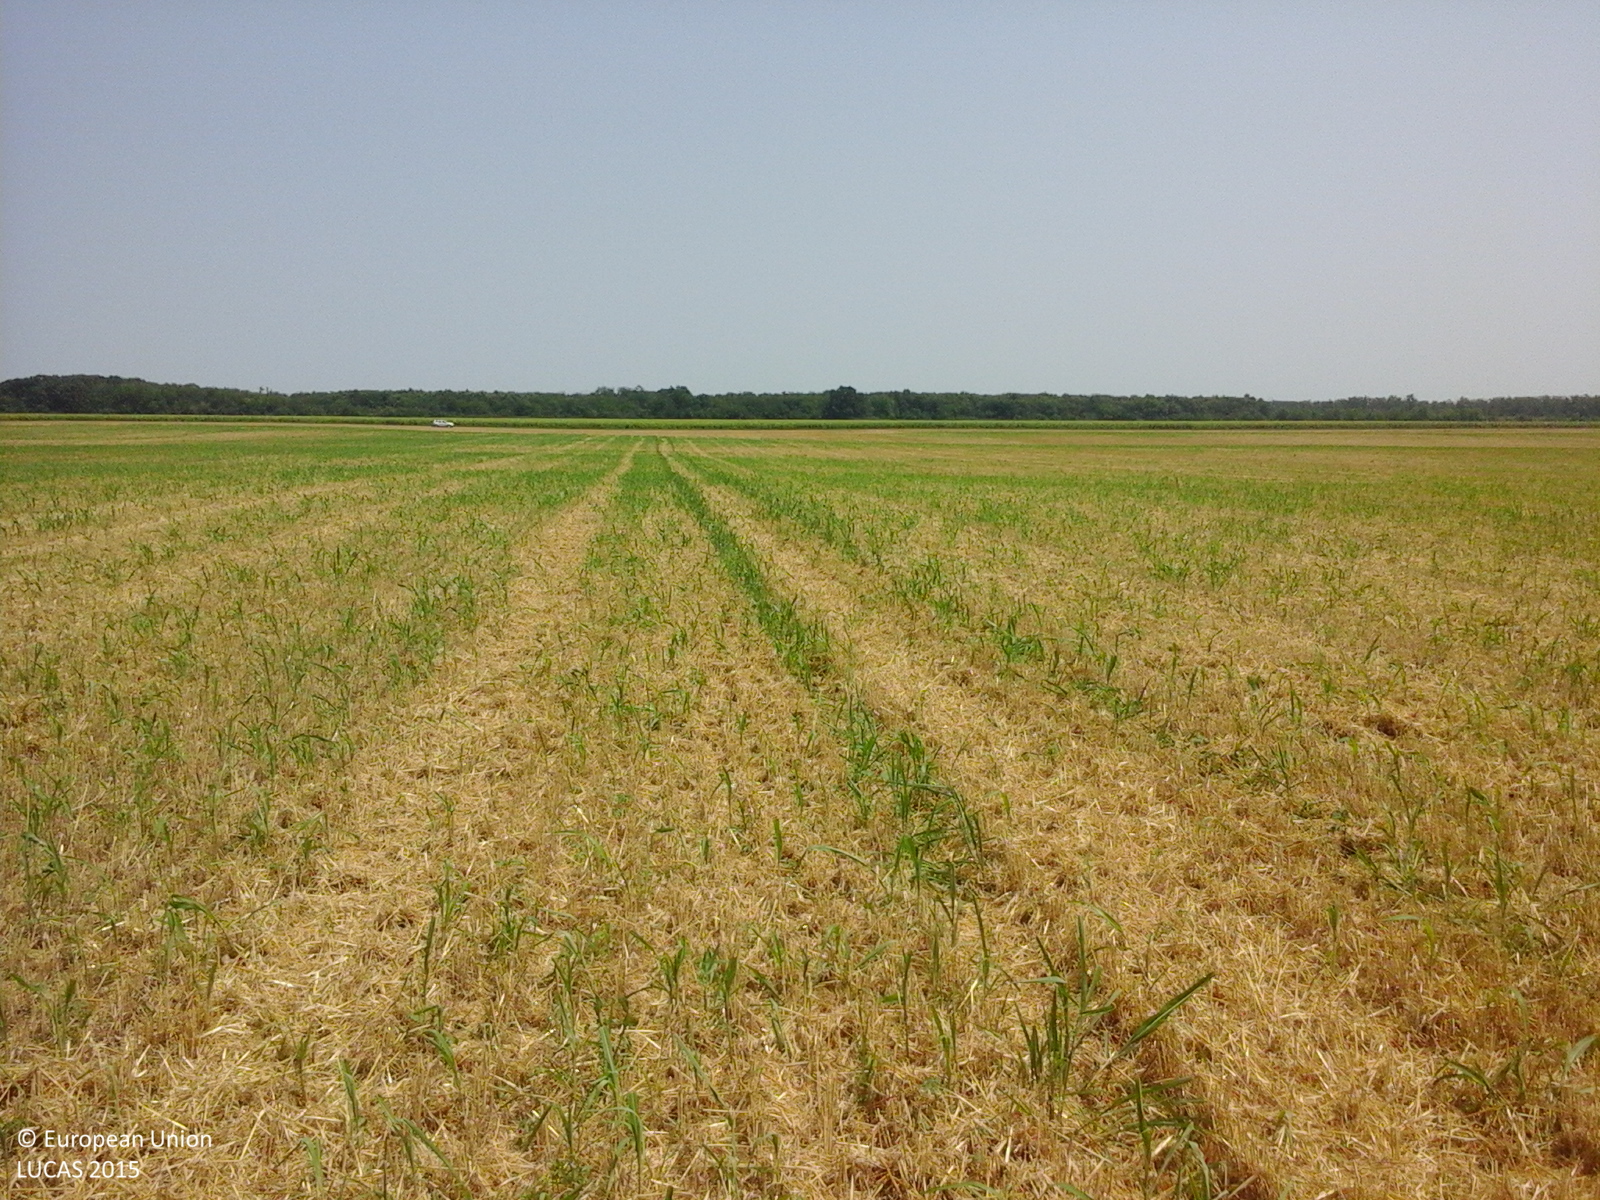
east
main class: Cropland
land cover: Common wheat
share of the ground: > 75 %
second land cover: Spontaneously vegetated surfaces
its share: 10 - 25 %
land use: Agriculture (excluding fallow land and kitchen gardens)
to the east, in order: Common wheat; Spontaneously vegetated surfaces
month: July
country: RO
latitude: 44.5621
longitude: 26.7289
